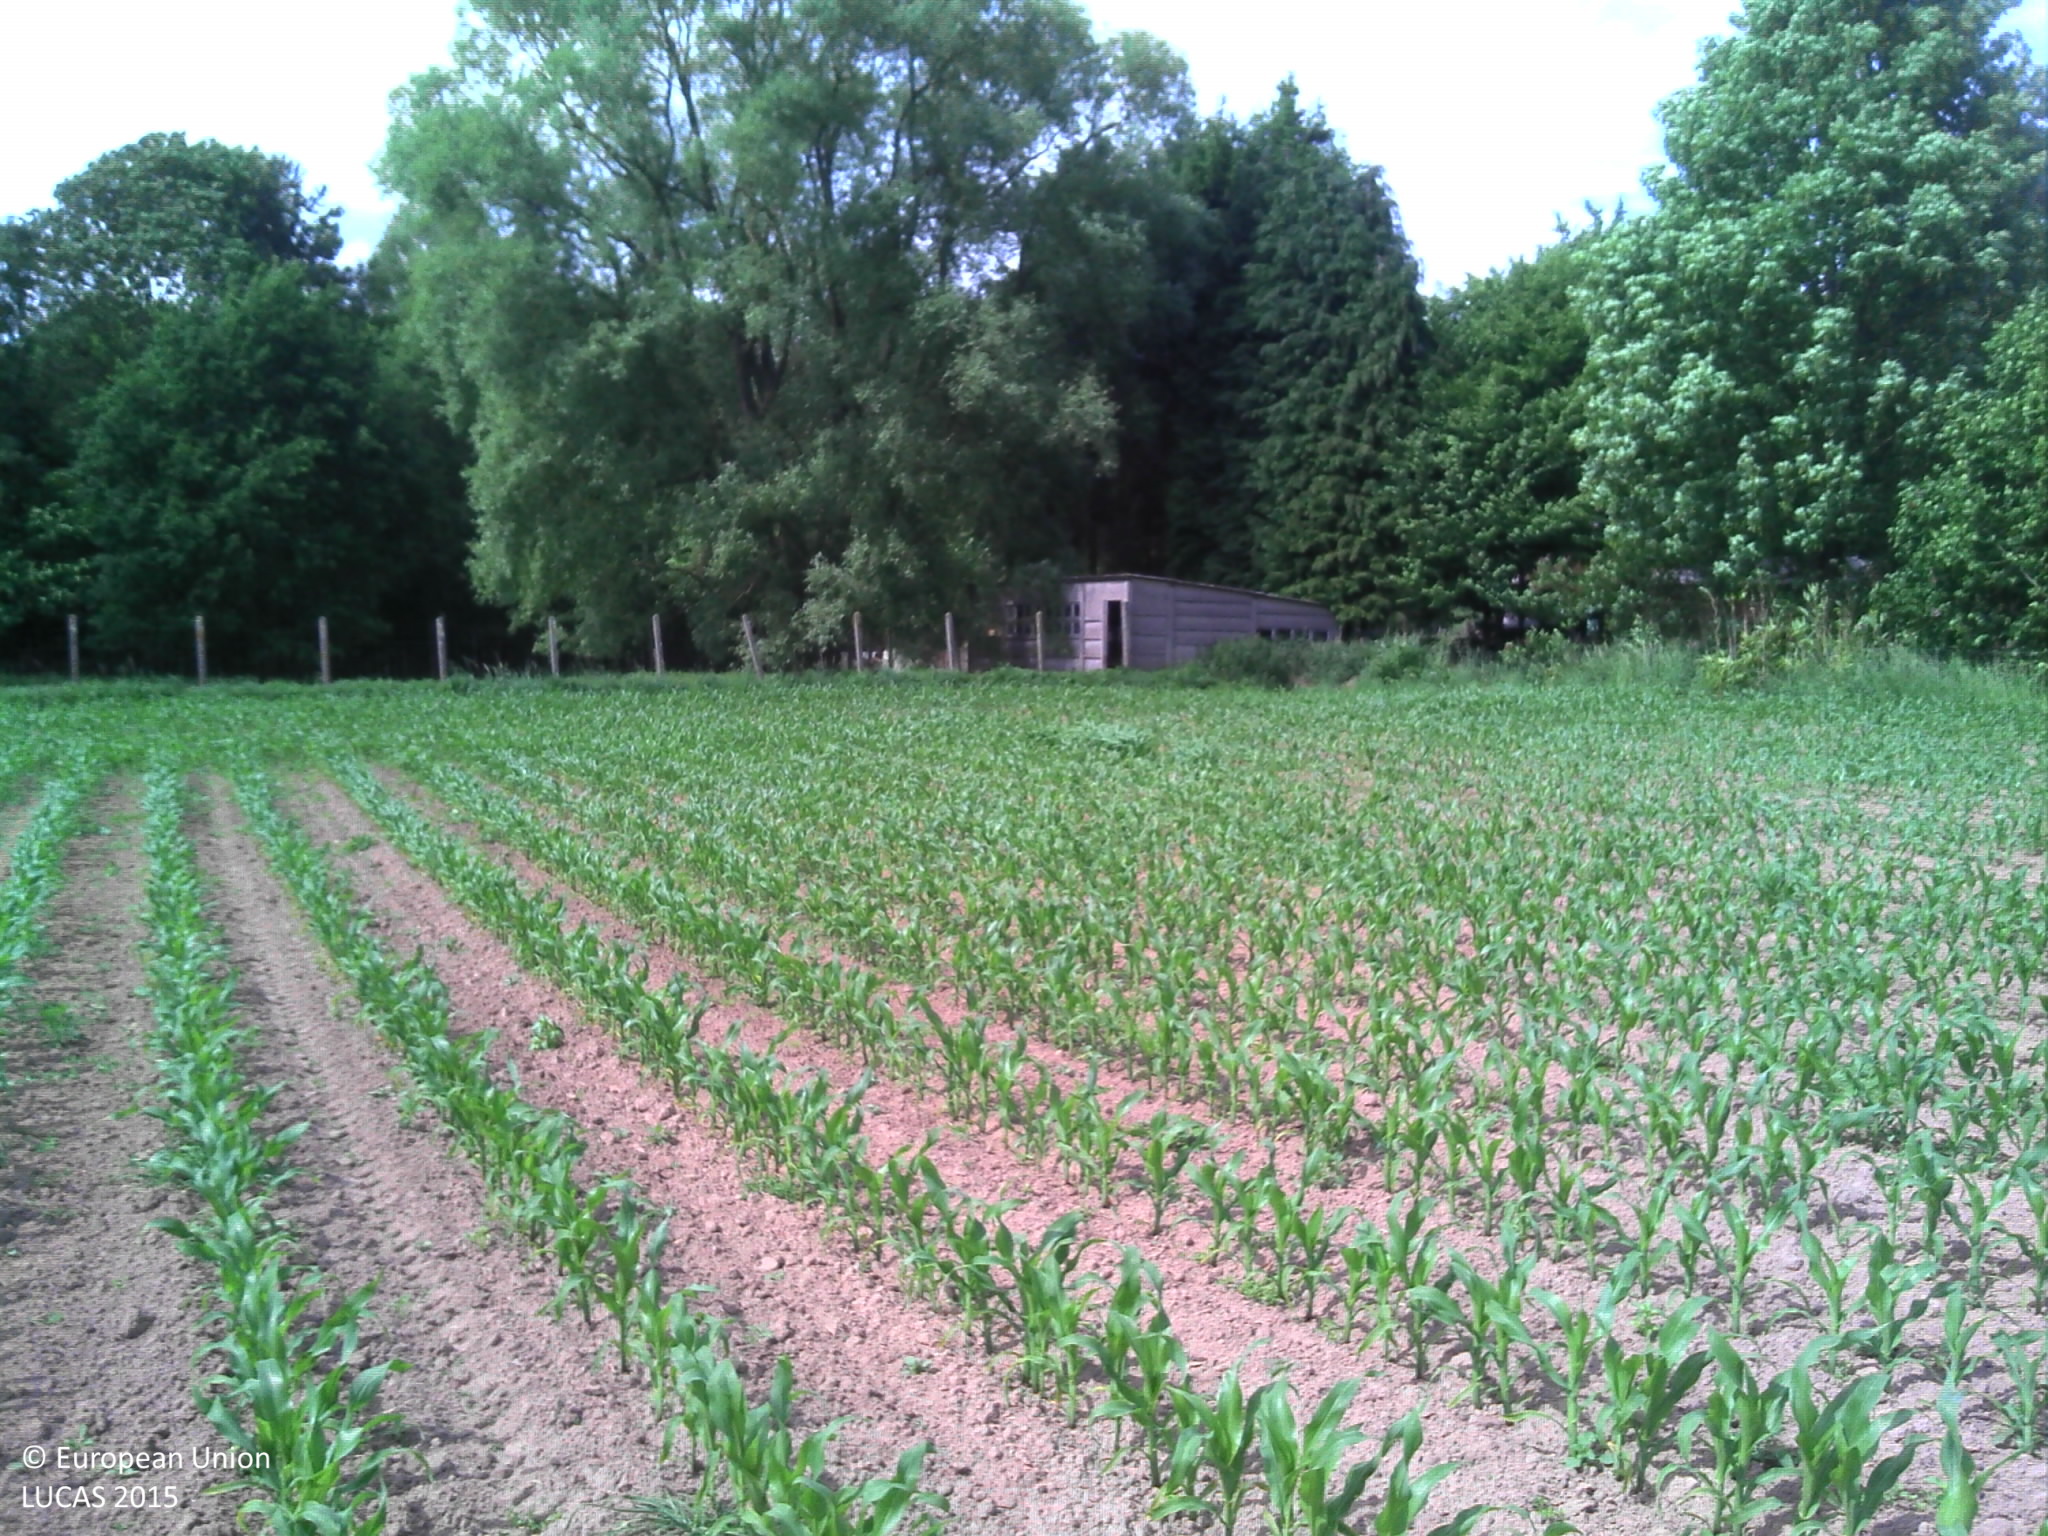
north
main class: Cropland
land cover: Maize
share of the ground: 25 - 50 %
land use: Agriculture (excluding fallow land and kitchen gardens)
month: May
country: BE
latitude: 50.7616
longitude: 4.6515
